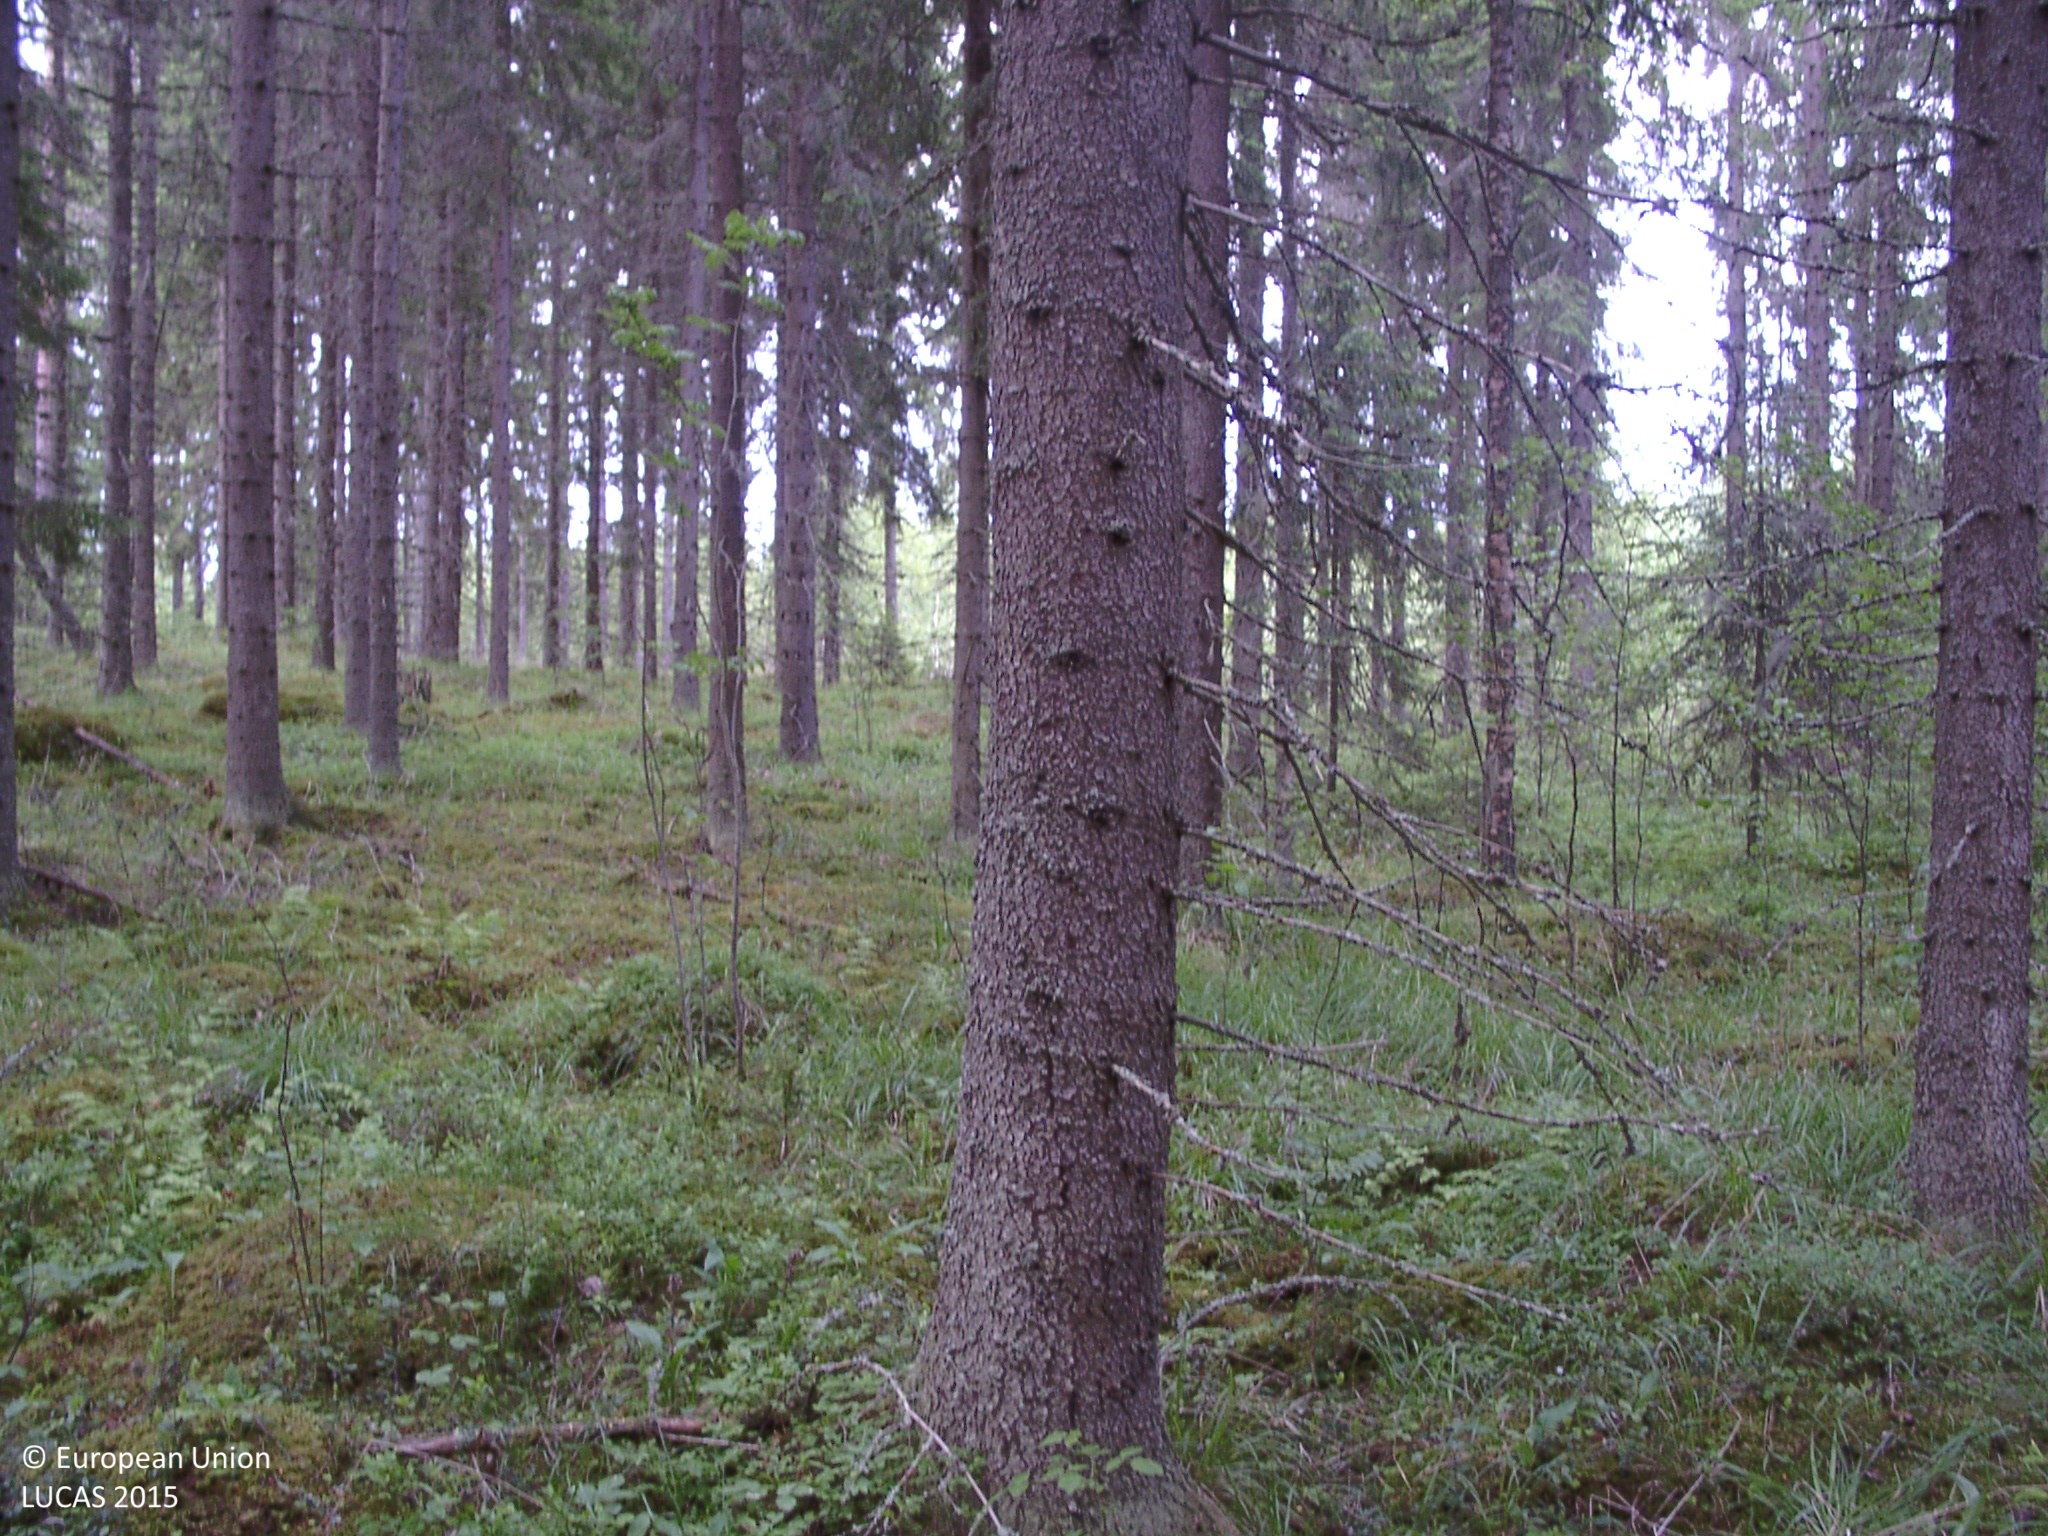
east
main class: Woodland
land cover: Spruce dominated coniferous woodland
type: boreal forest
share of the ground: 50 - 75 %
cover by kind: coniferous forest trees 65 %, herbaceous plants 15 %, lichens and mosses 10 %, broadleaved forest trees 5 %, shrubs 5 %
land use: Forestry
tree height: > 5 m
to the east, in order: Spruce dominated coniferous woodland; Broadleaved woodland; Ditches and canals; Tracks; Ditches and canals; Spruce dominated mixed woodland; Ditches and canals; Spruce dominated coniferous woodland
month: June
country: FI
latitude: 61.6143
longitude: 24.8311
